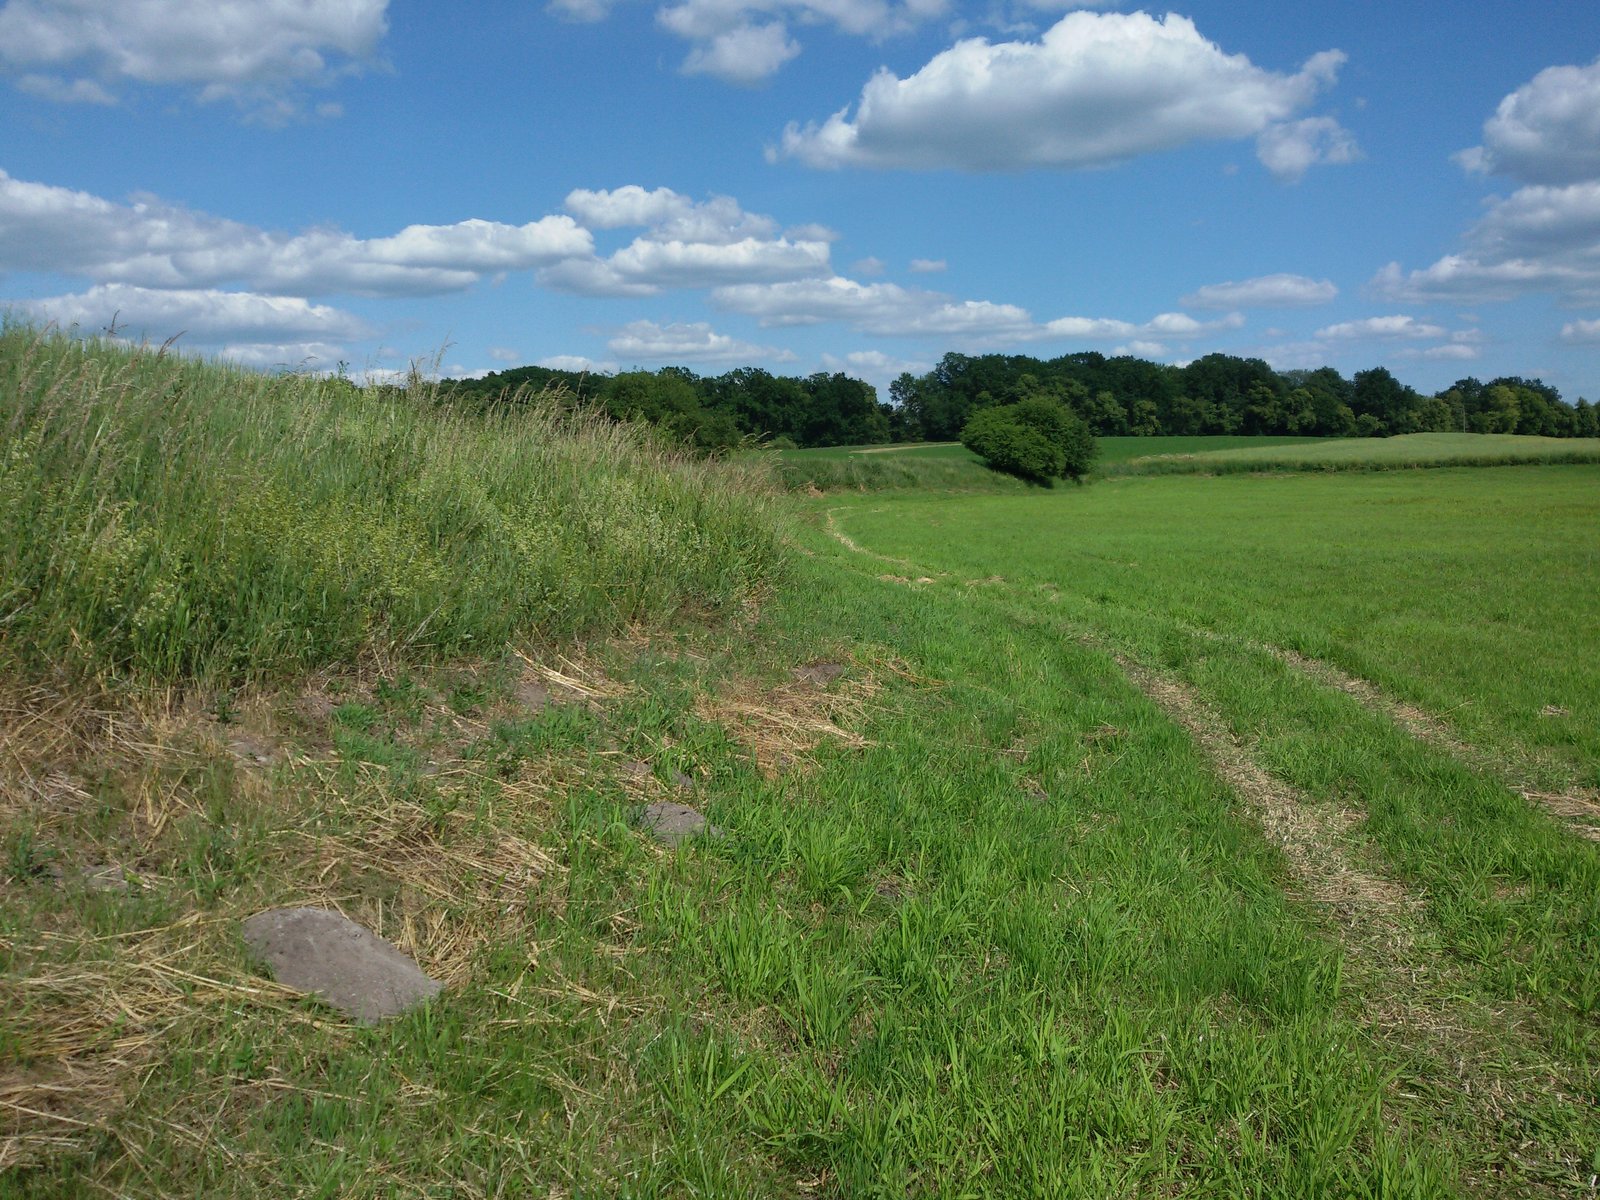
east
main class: Grassland
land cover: Grassland without tree/shrub cover
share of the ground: > 75 %
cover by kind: herbaceous plants 100 %
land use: Agriculture (excluding fallow land and kitchen gardens)
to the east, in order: Grassland without tree/shrub cover; Clovers
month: June
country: PL
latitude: 52.6417
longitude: 16.9702
